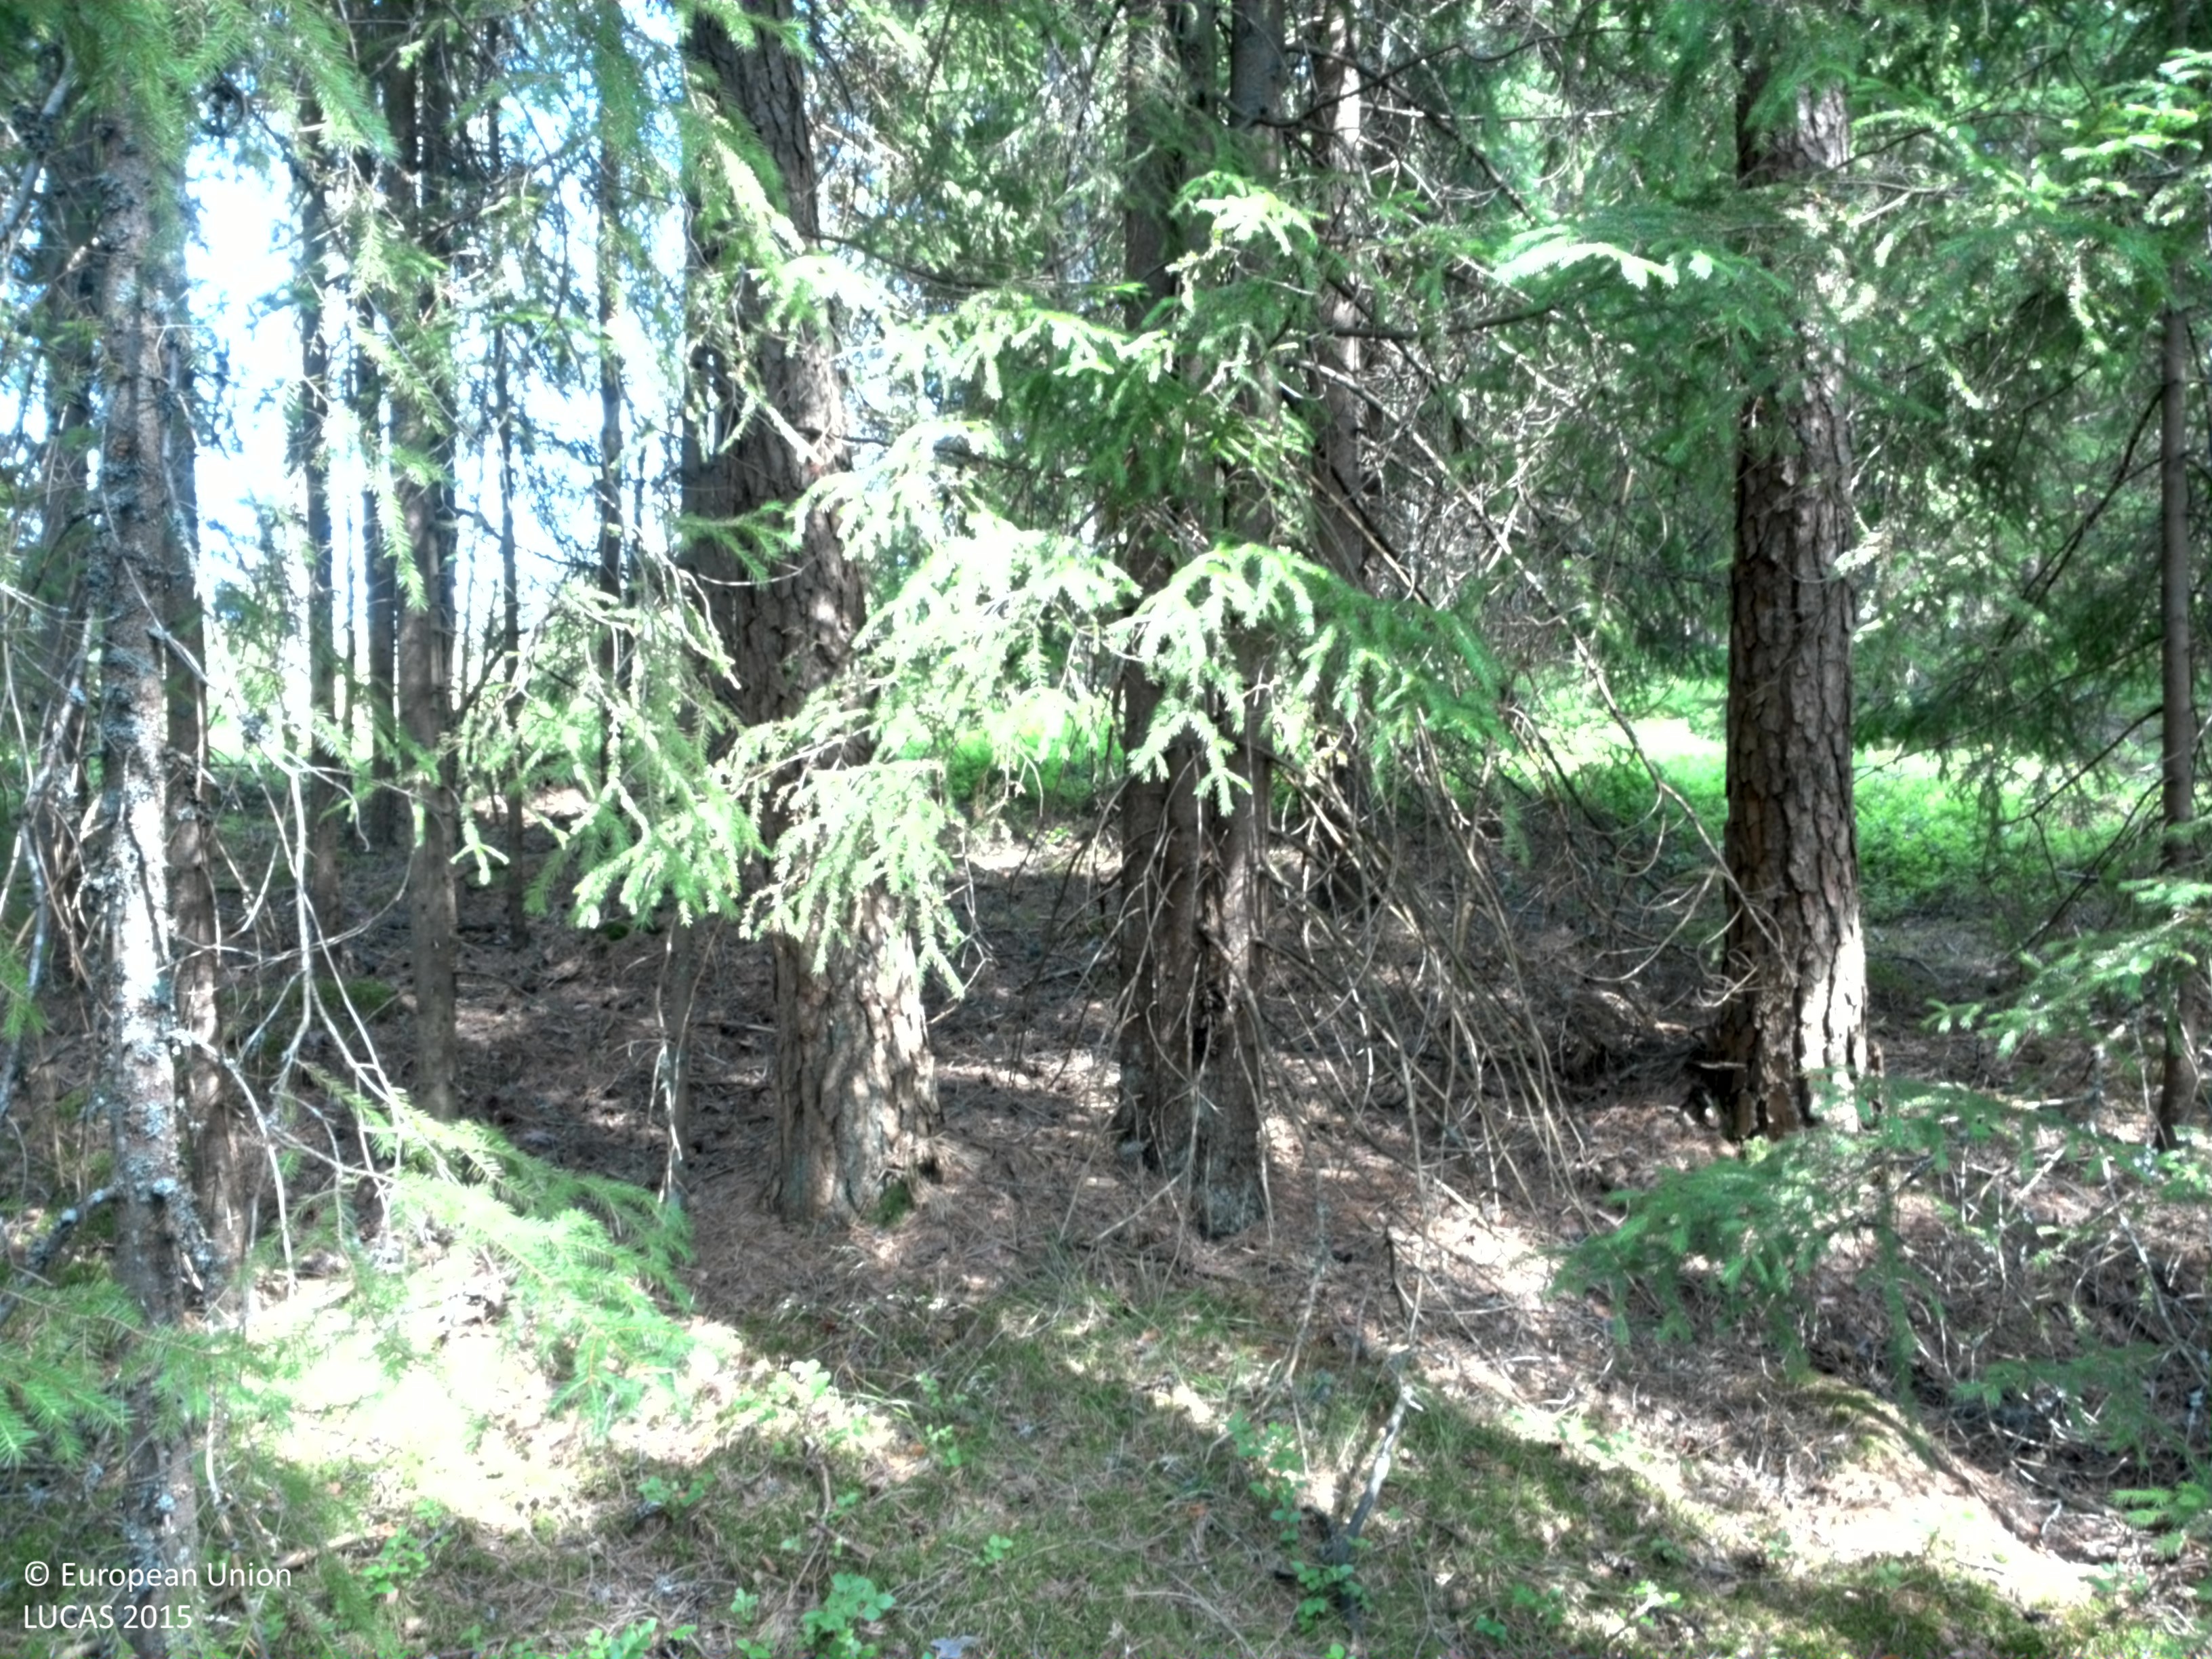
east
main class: Woodland
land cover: Pine dominated coniferous woodland
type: boreal forest
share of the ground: 50 - 75 %
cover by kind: coniferous forest trees 75 %, lichens and mosses 20 %, shrubs 5 %
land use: Forestry
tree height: > 5 m
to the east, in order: Pine dominated coniferous woodland; Spruce dominated coniferous woodland; Pine dominated coniferous woodland
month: July
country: SE
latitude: 57.6578
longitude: 13.9337
